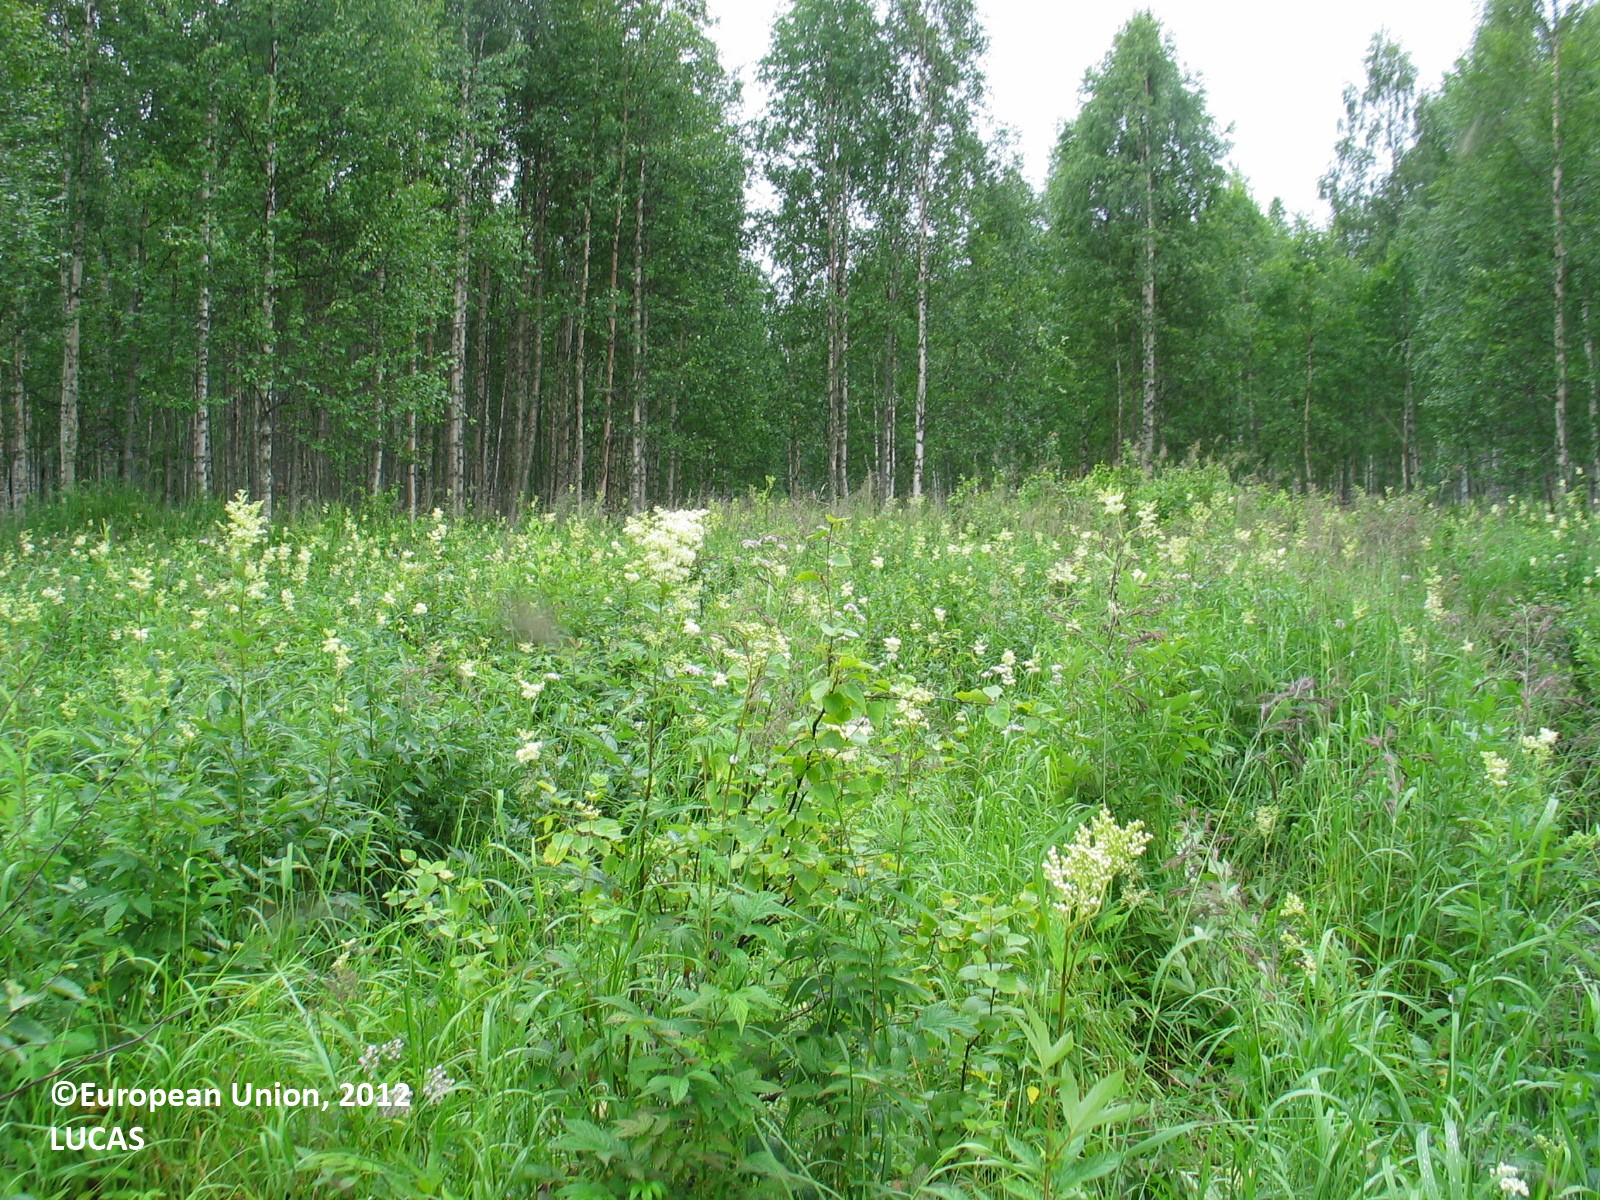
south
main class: Grassland
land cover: Spontaneously vegetated surfaces
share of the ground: > 75 %
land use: Forestry
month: July
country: FI
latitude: 65.8511
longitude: 25.2929
